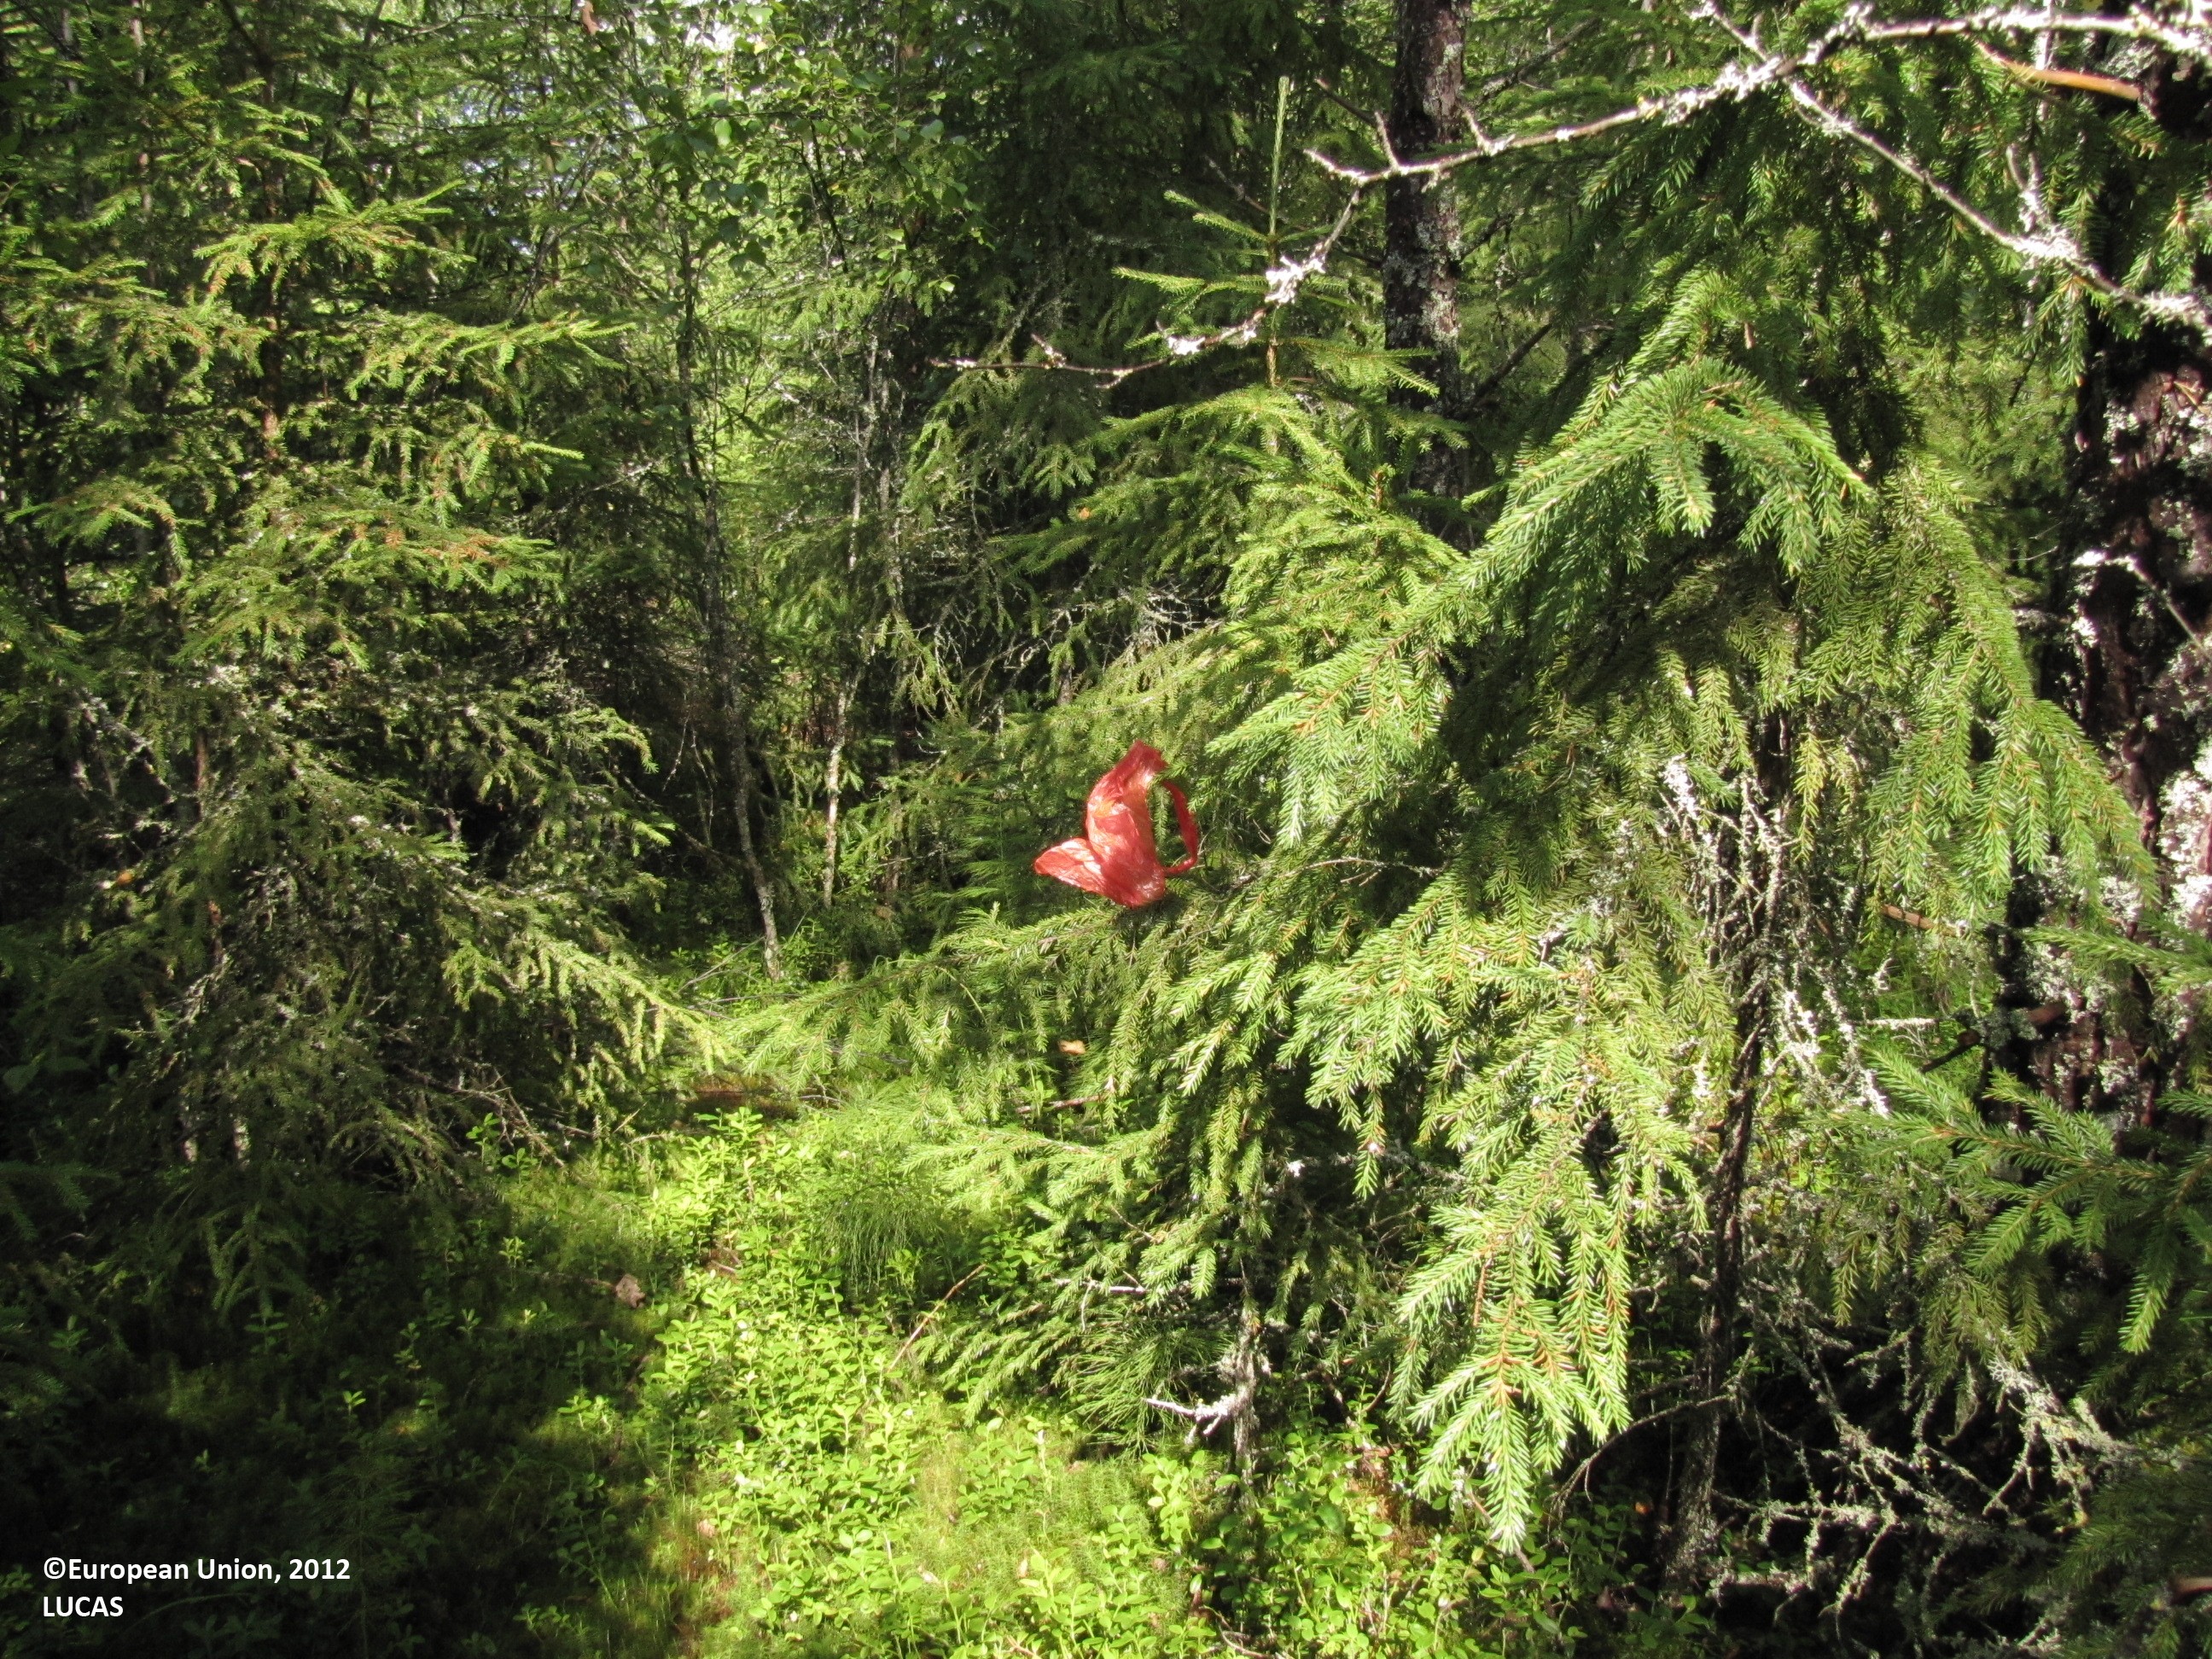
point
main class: Woodland
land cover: Other coniferous woodland
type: boreal forest
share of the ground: 50 - 75 %
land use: Forestry
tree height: > 5 m
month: July
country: FI
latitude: 62.2389
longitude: 23.0953
